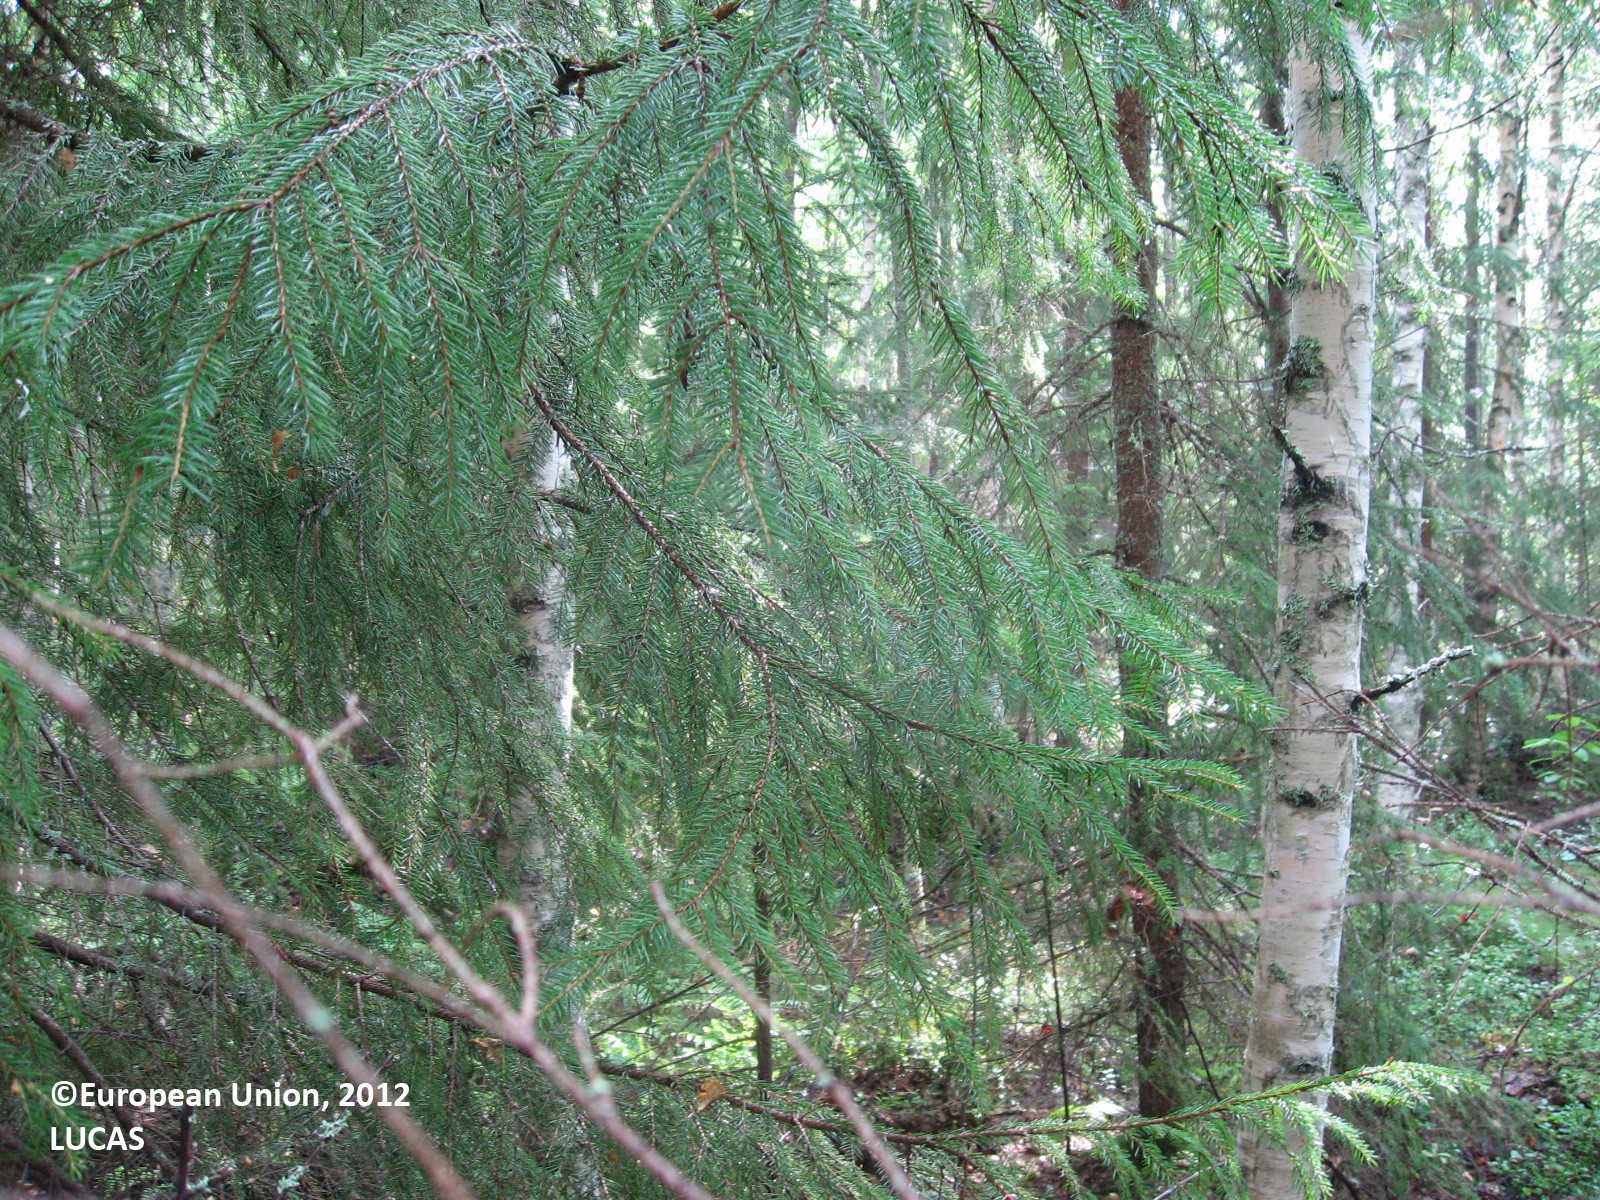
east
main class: Woodland
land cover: Spruce dominated mixed woodland
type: boreal forest
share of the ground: > 75 %
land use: Forestry
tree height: > 5 m
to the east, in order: Spruce dominated mixed woodland; Pine dominated mixed woodland
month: August
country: FI
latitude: 61.6052
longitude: 25.0968
